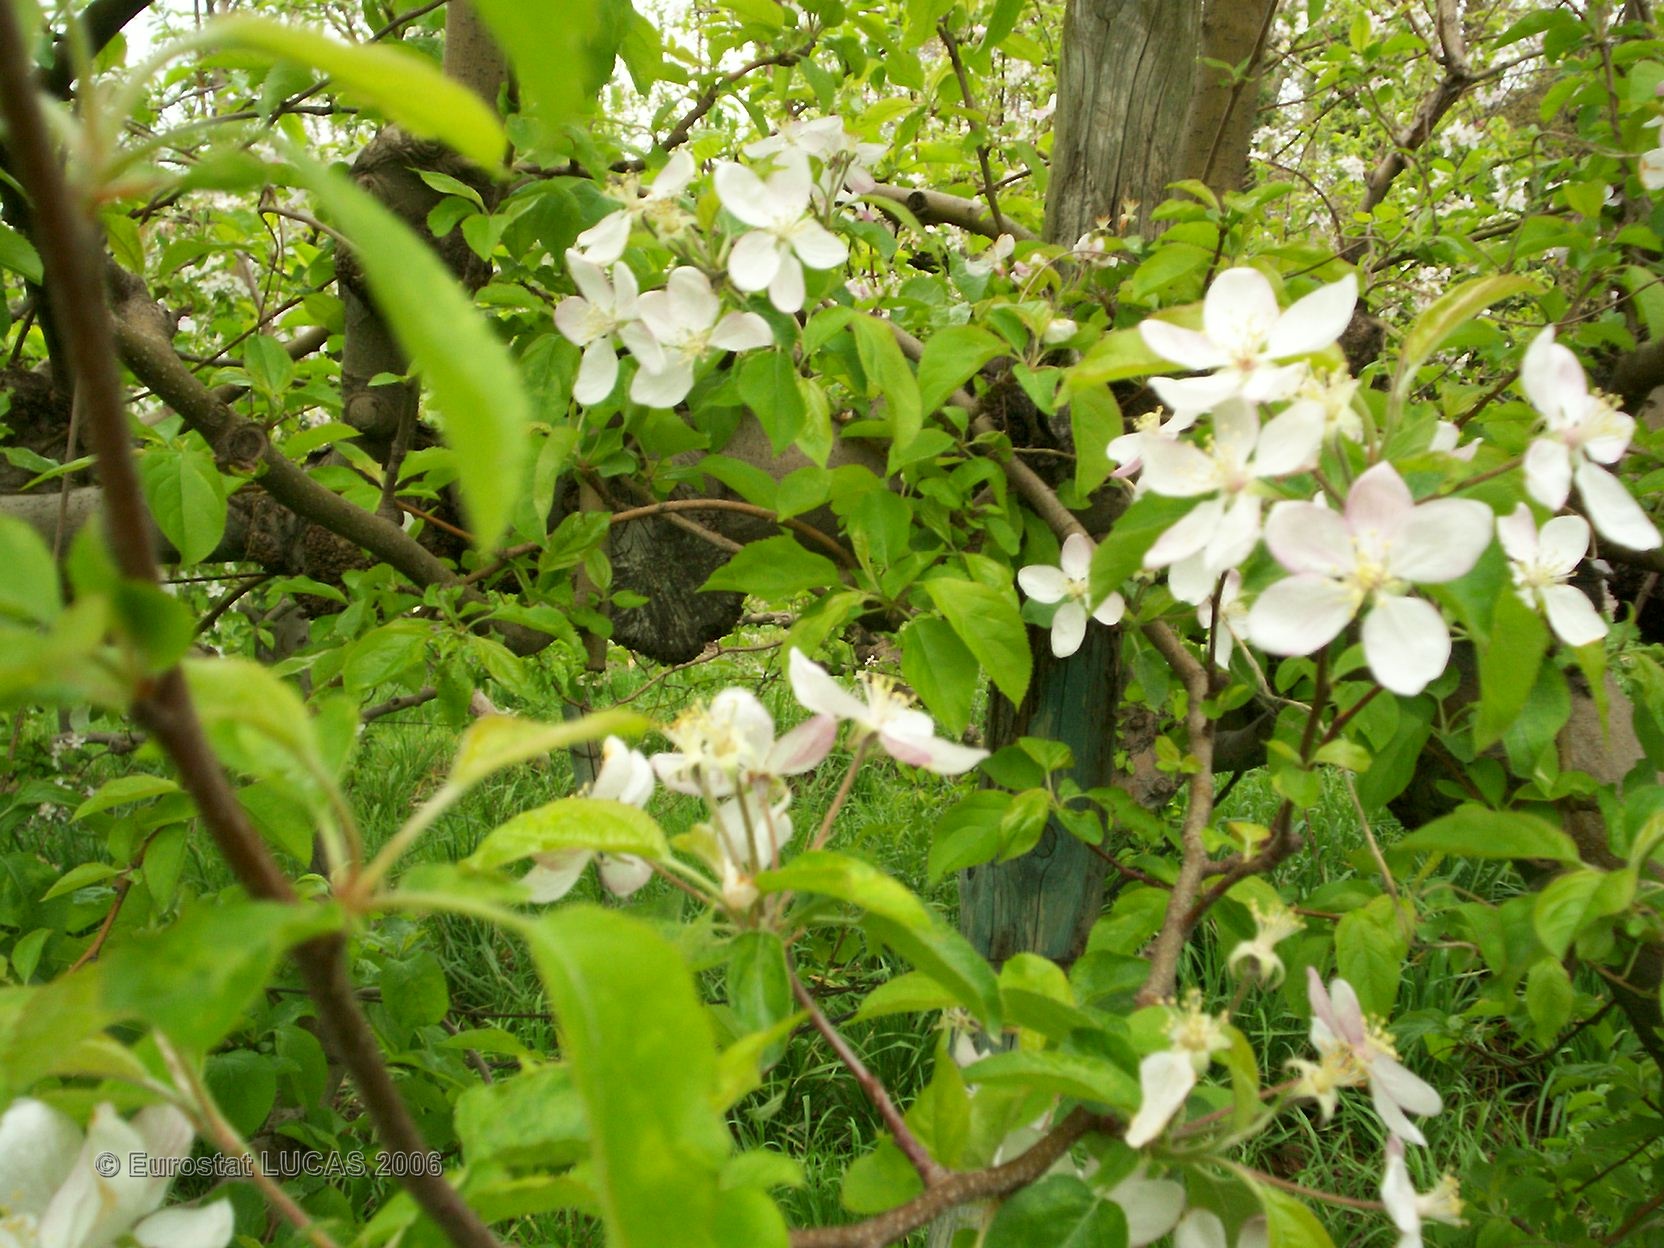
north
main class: Cropland
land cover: Apple fruit
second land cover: Grassland with sparse tree/shrub cover
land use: Agriculture (excluding fallow land and kitchen gardens)
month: April
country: FR
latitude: 43.8095
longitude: 4.8998
